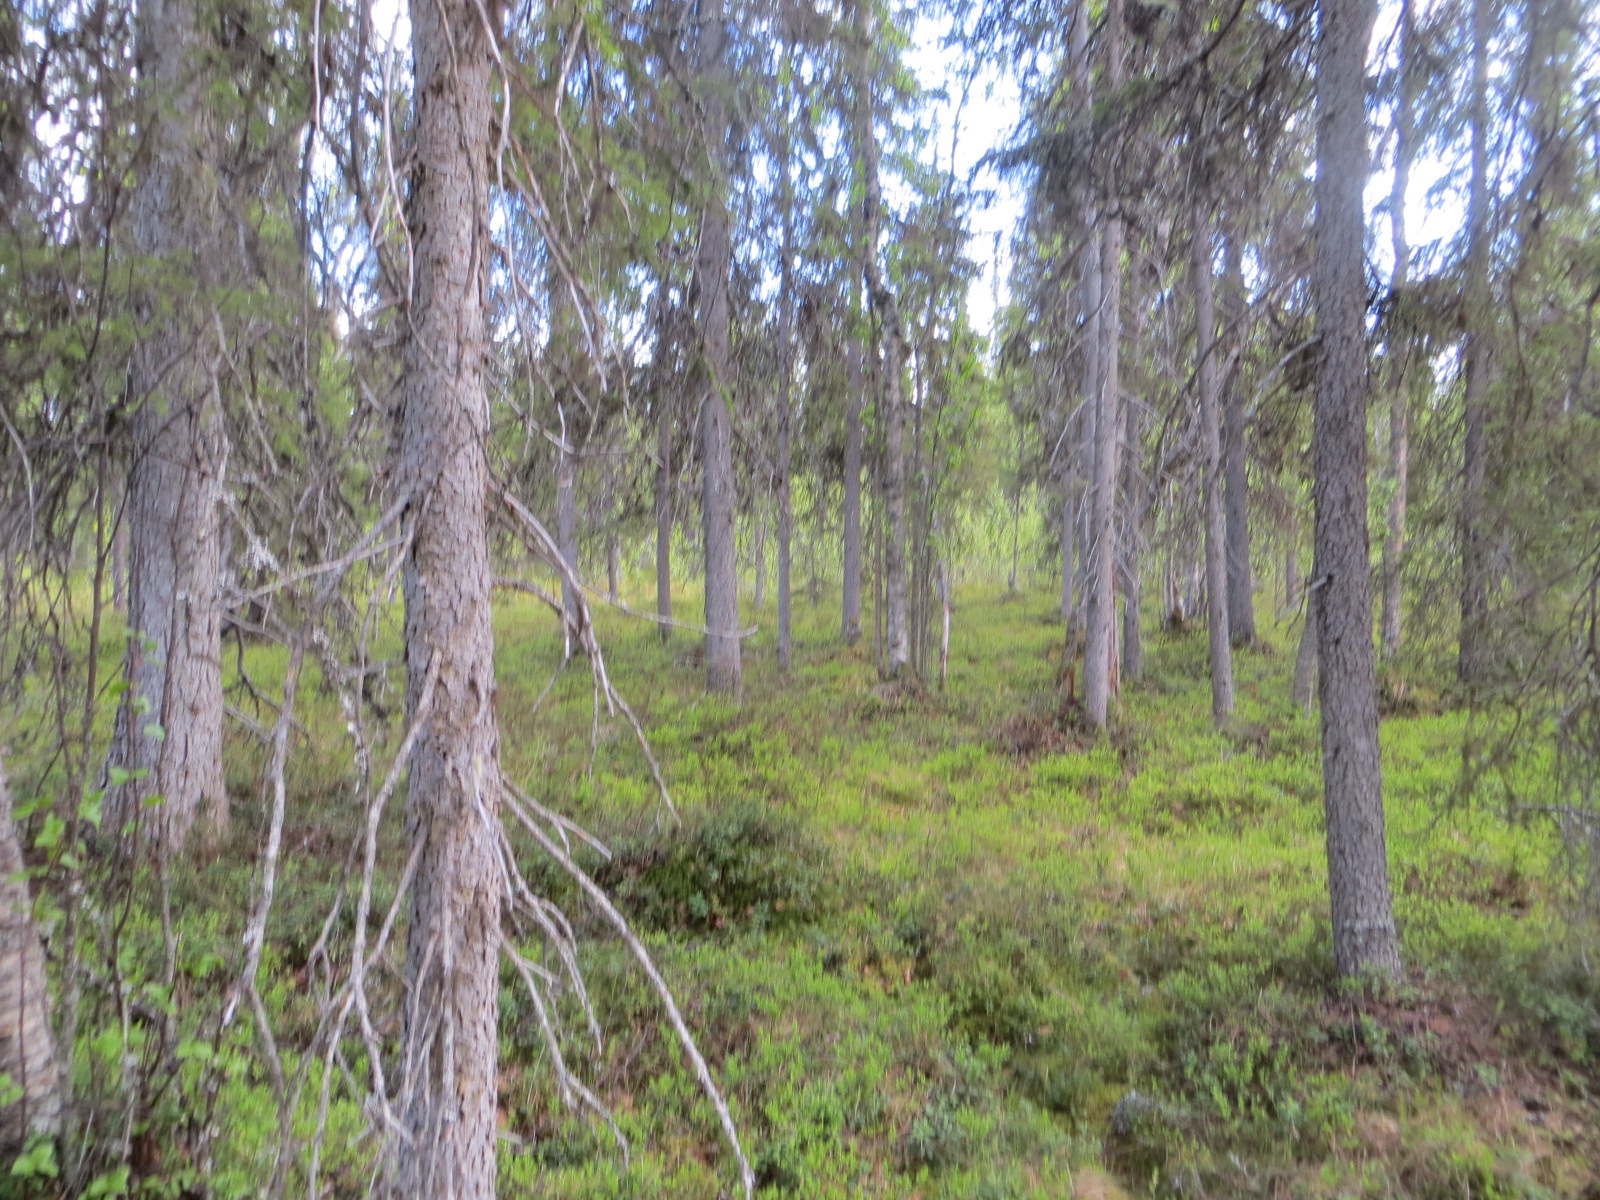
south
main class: Woodland
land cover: Spruce dominated mixed woodland
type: boreal forest
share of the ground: 50 - 75 %
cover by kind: coniferous forest trees 60 %, broadleaved forest trees 20 %, shrubs 20 %
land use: Forestry
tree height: > 5 m
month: June
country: FI
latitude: 67.4881
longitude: 25.8548
